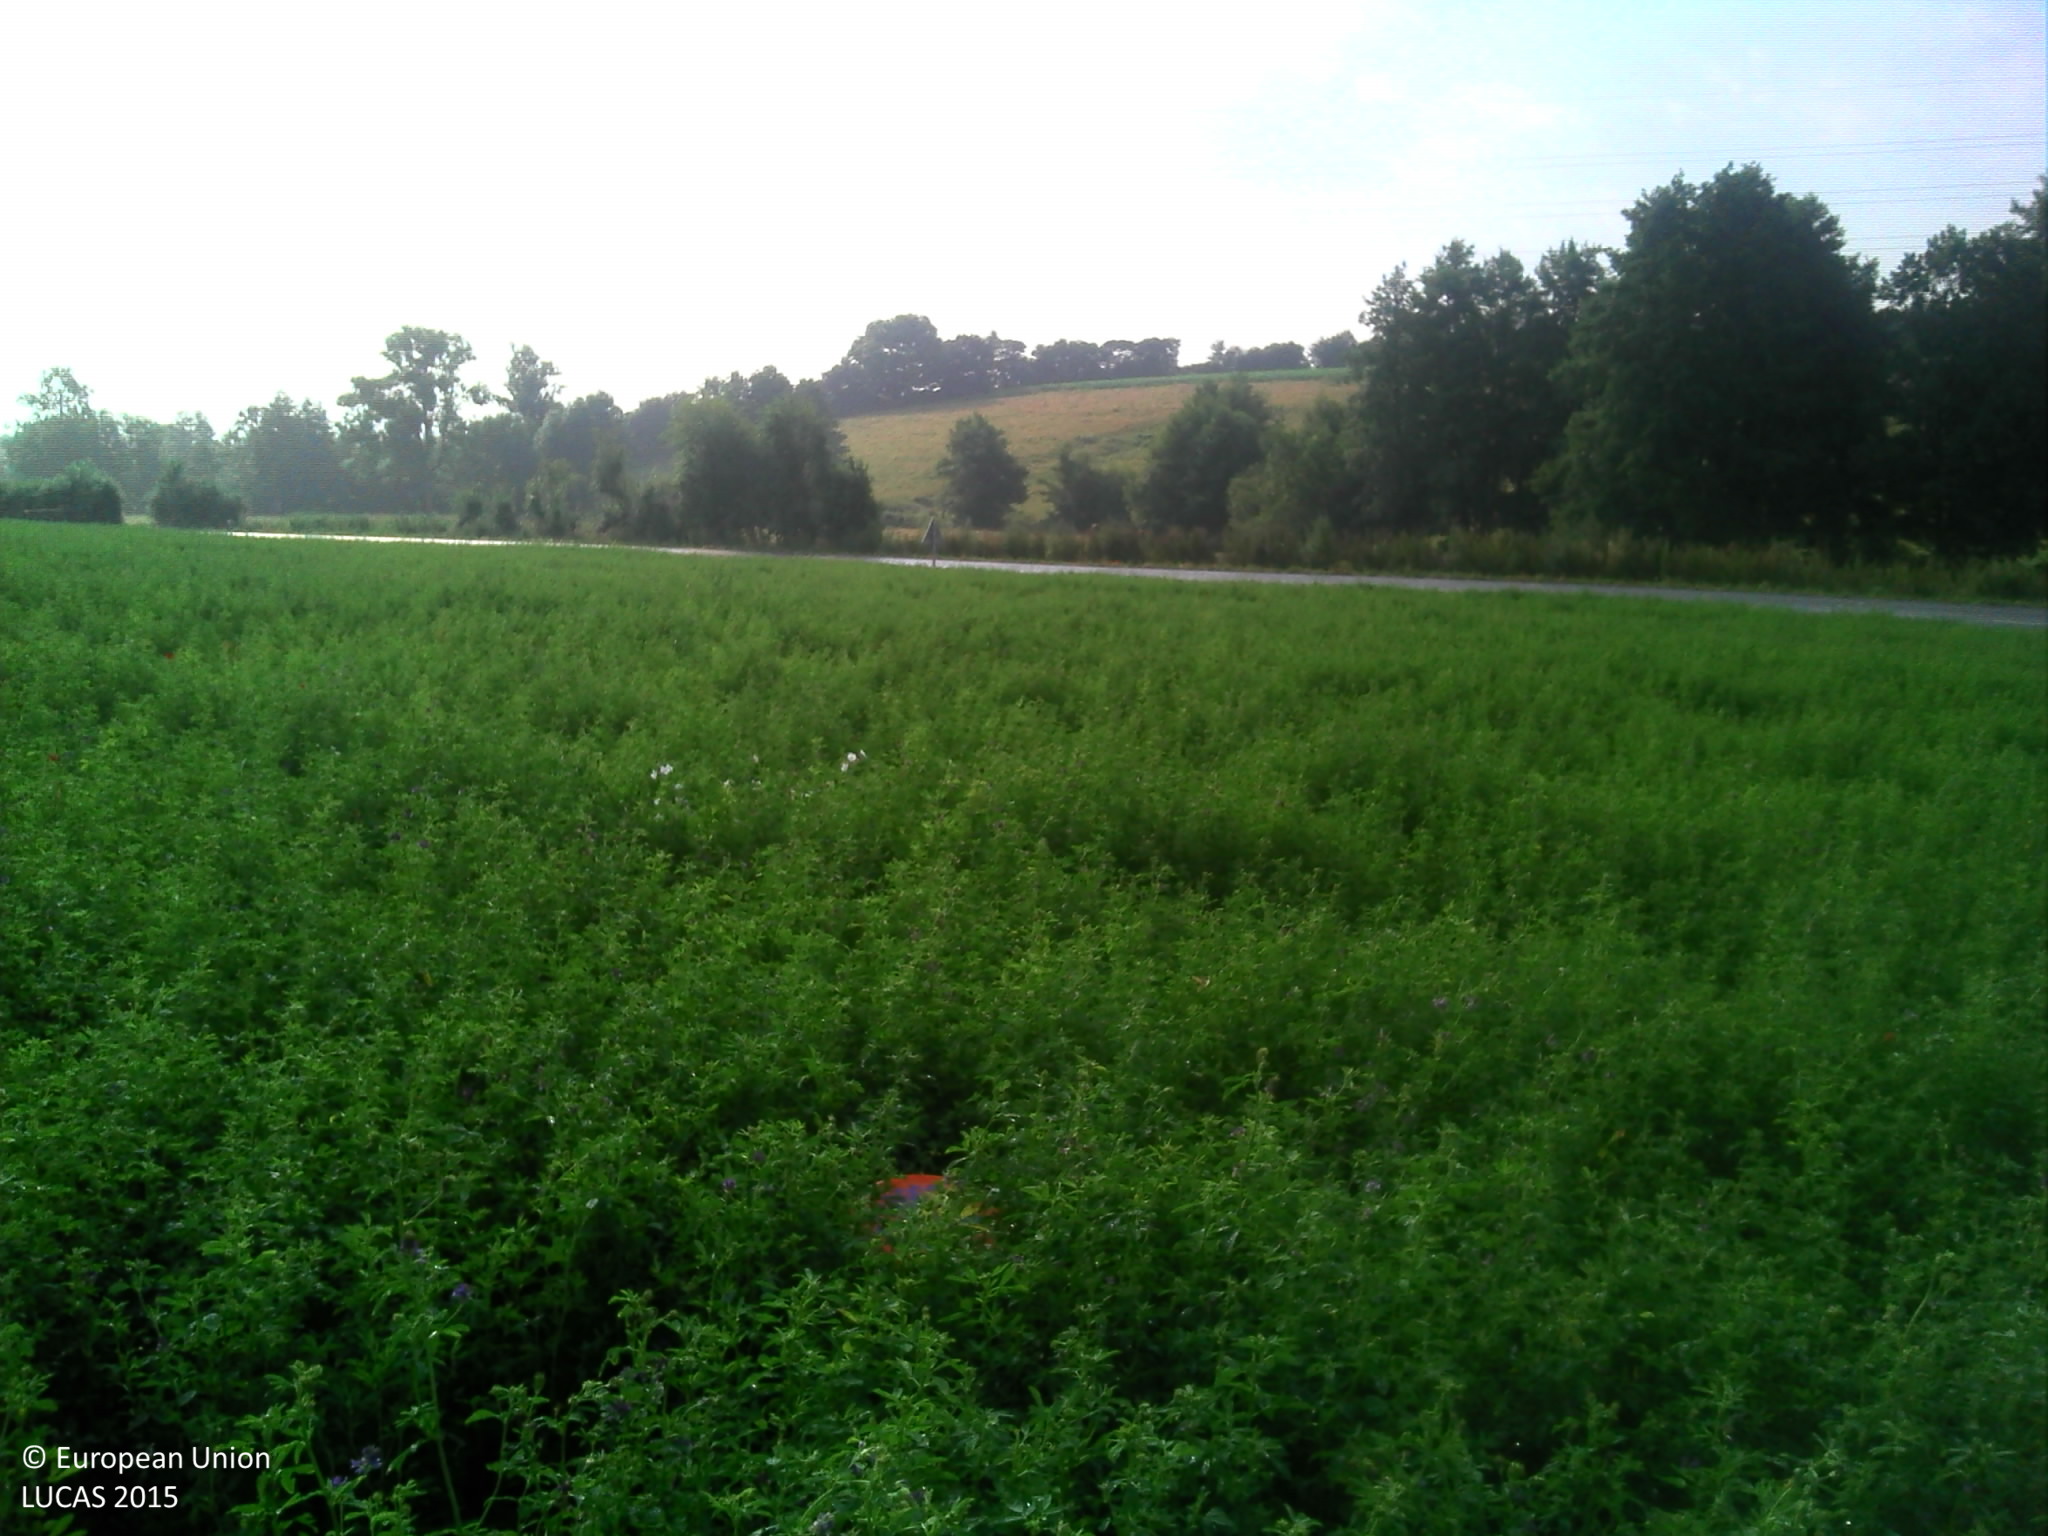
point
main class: Cropland
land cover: Lucerne
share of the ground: > 75 %
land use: Agriculture (excluding fallow land and kitchen gardens)
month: July
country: FR
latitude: 48.1657
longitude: 0.6055
